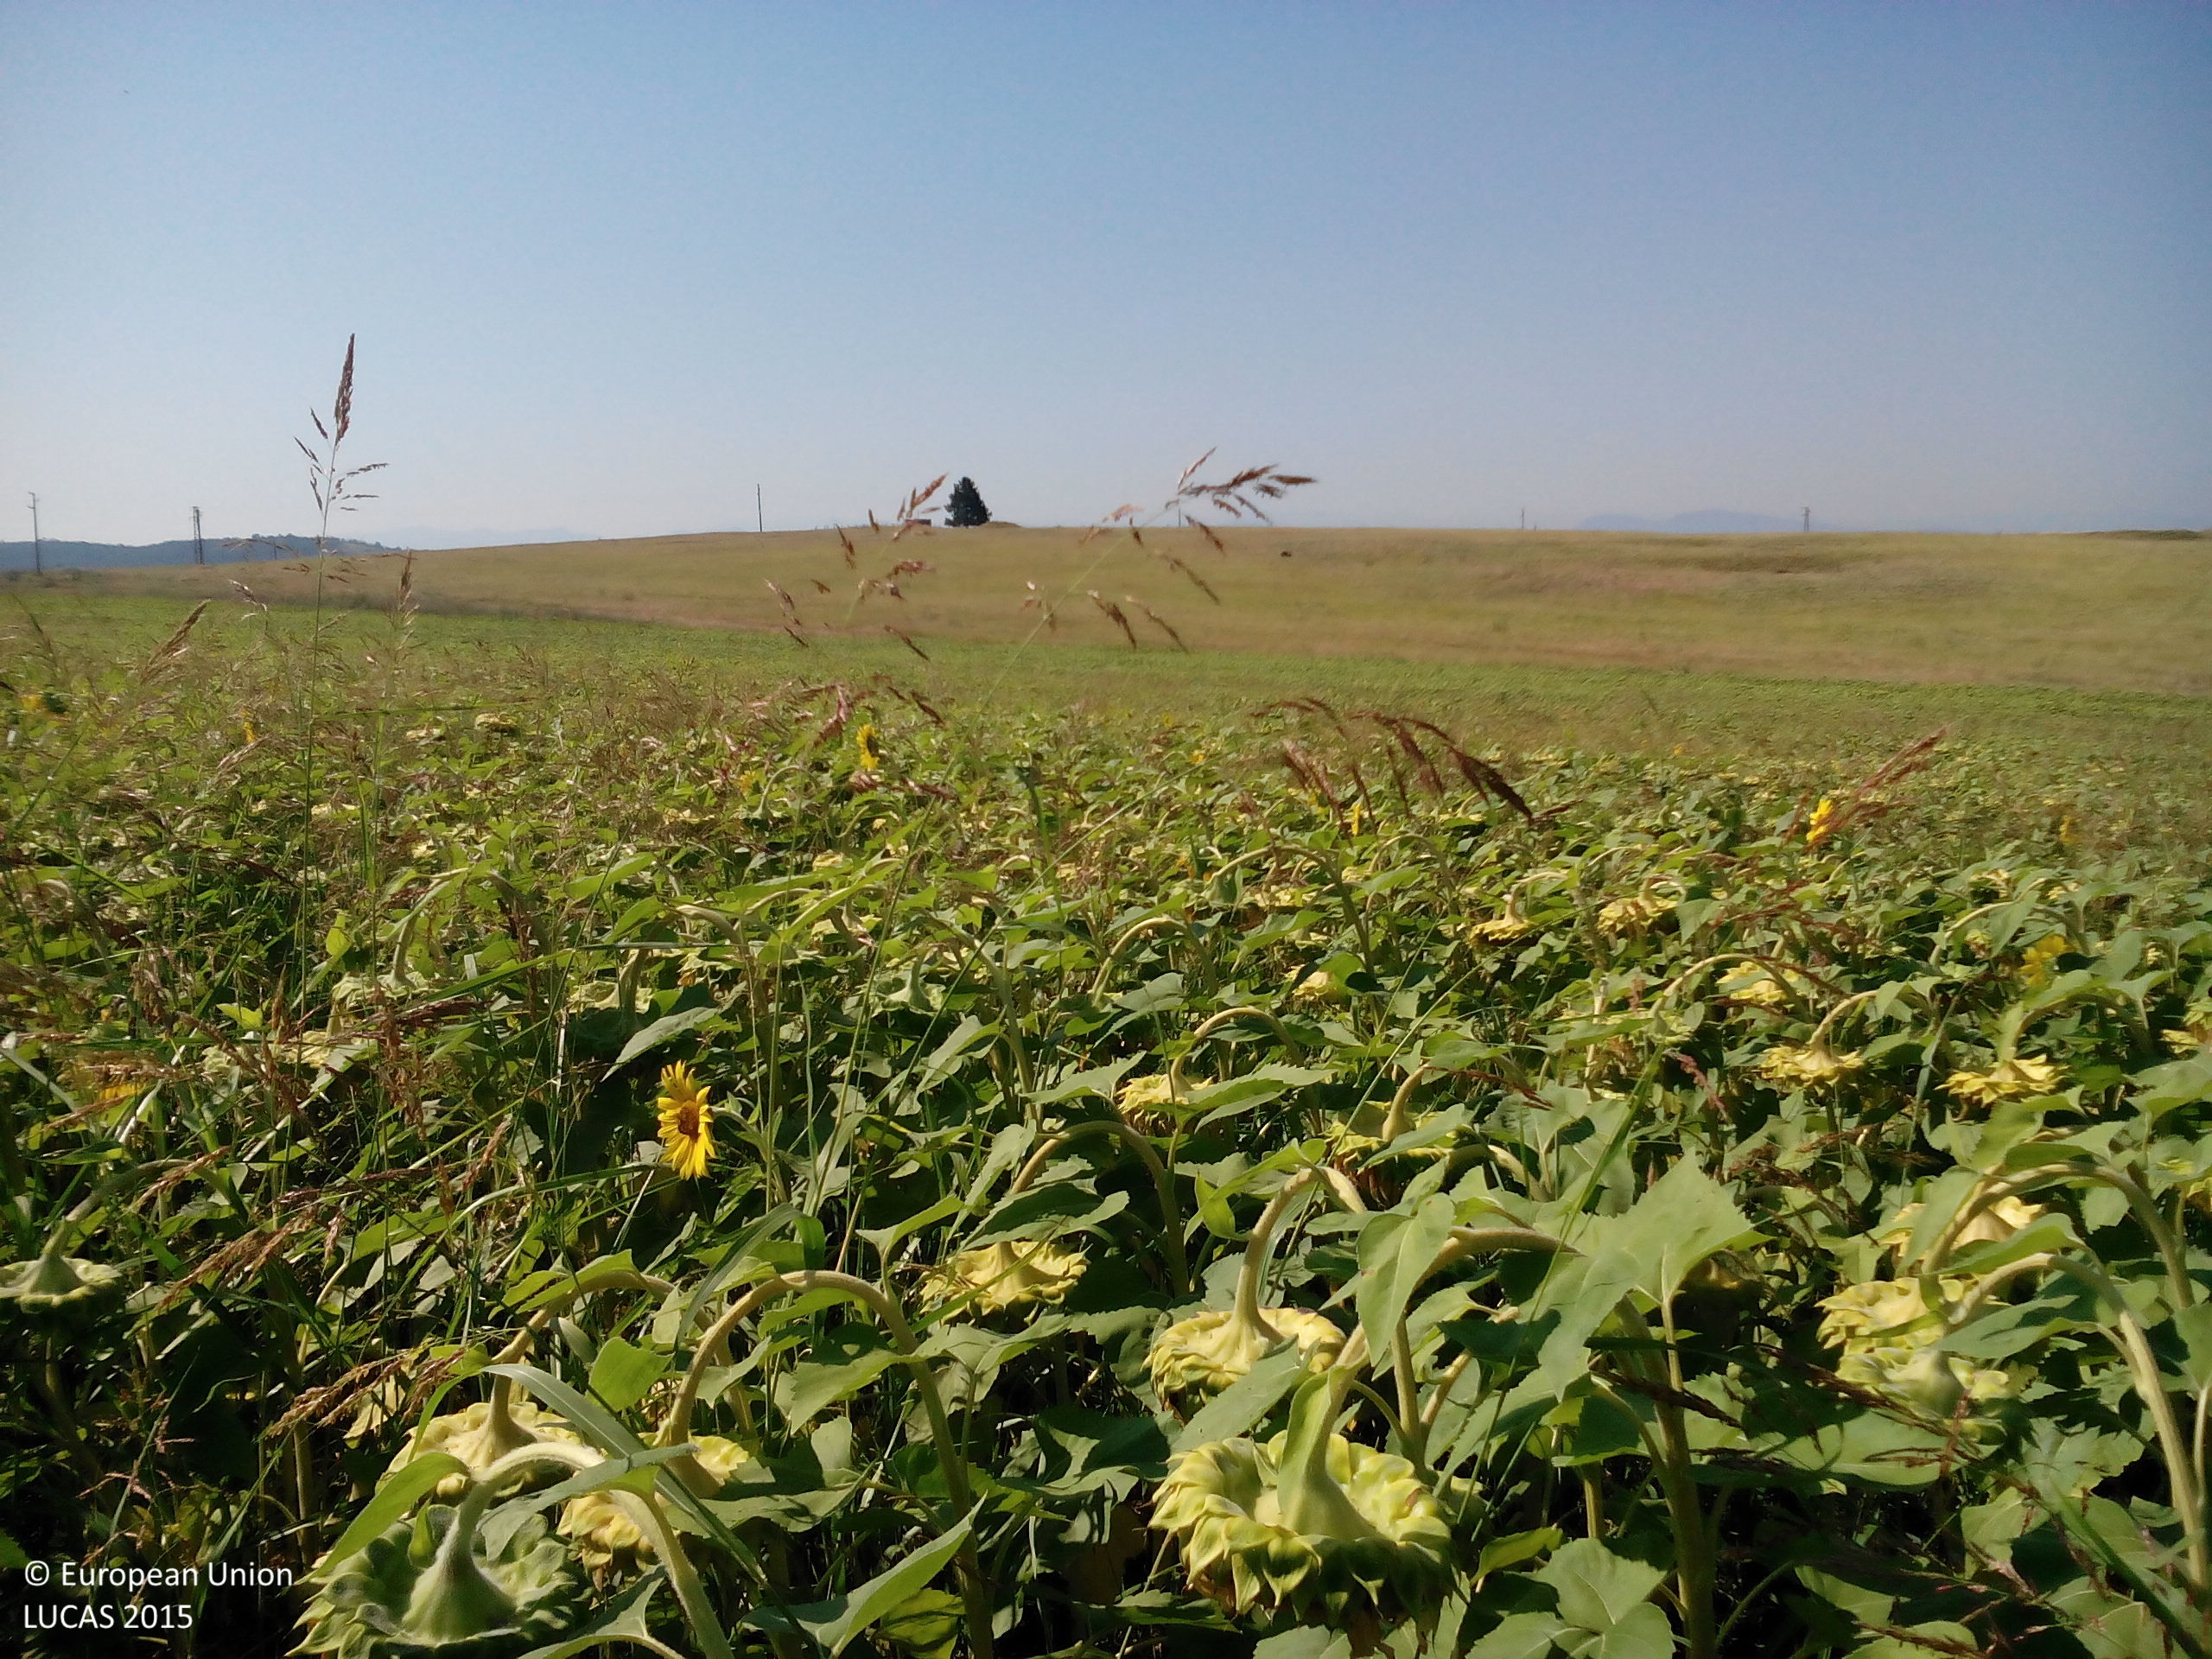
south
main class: Cropland
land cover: Sunflower
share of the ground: > 75 %
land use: Agriculture (excluding fallow land and kitchen gardens)
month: July
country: BG
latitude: 43.2574
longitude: 24.2077
